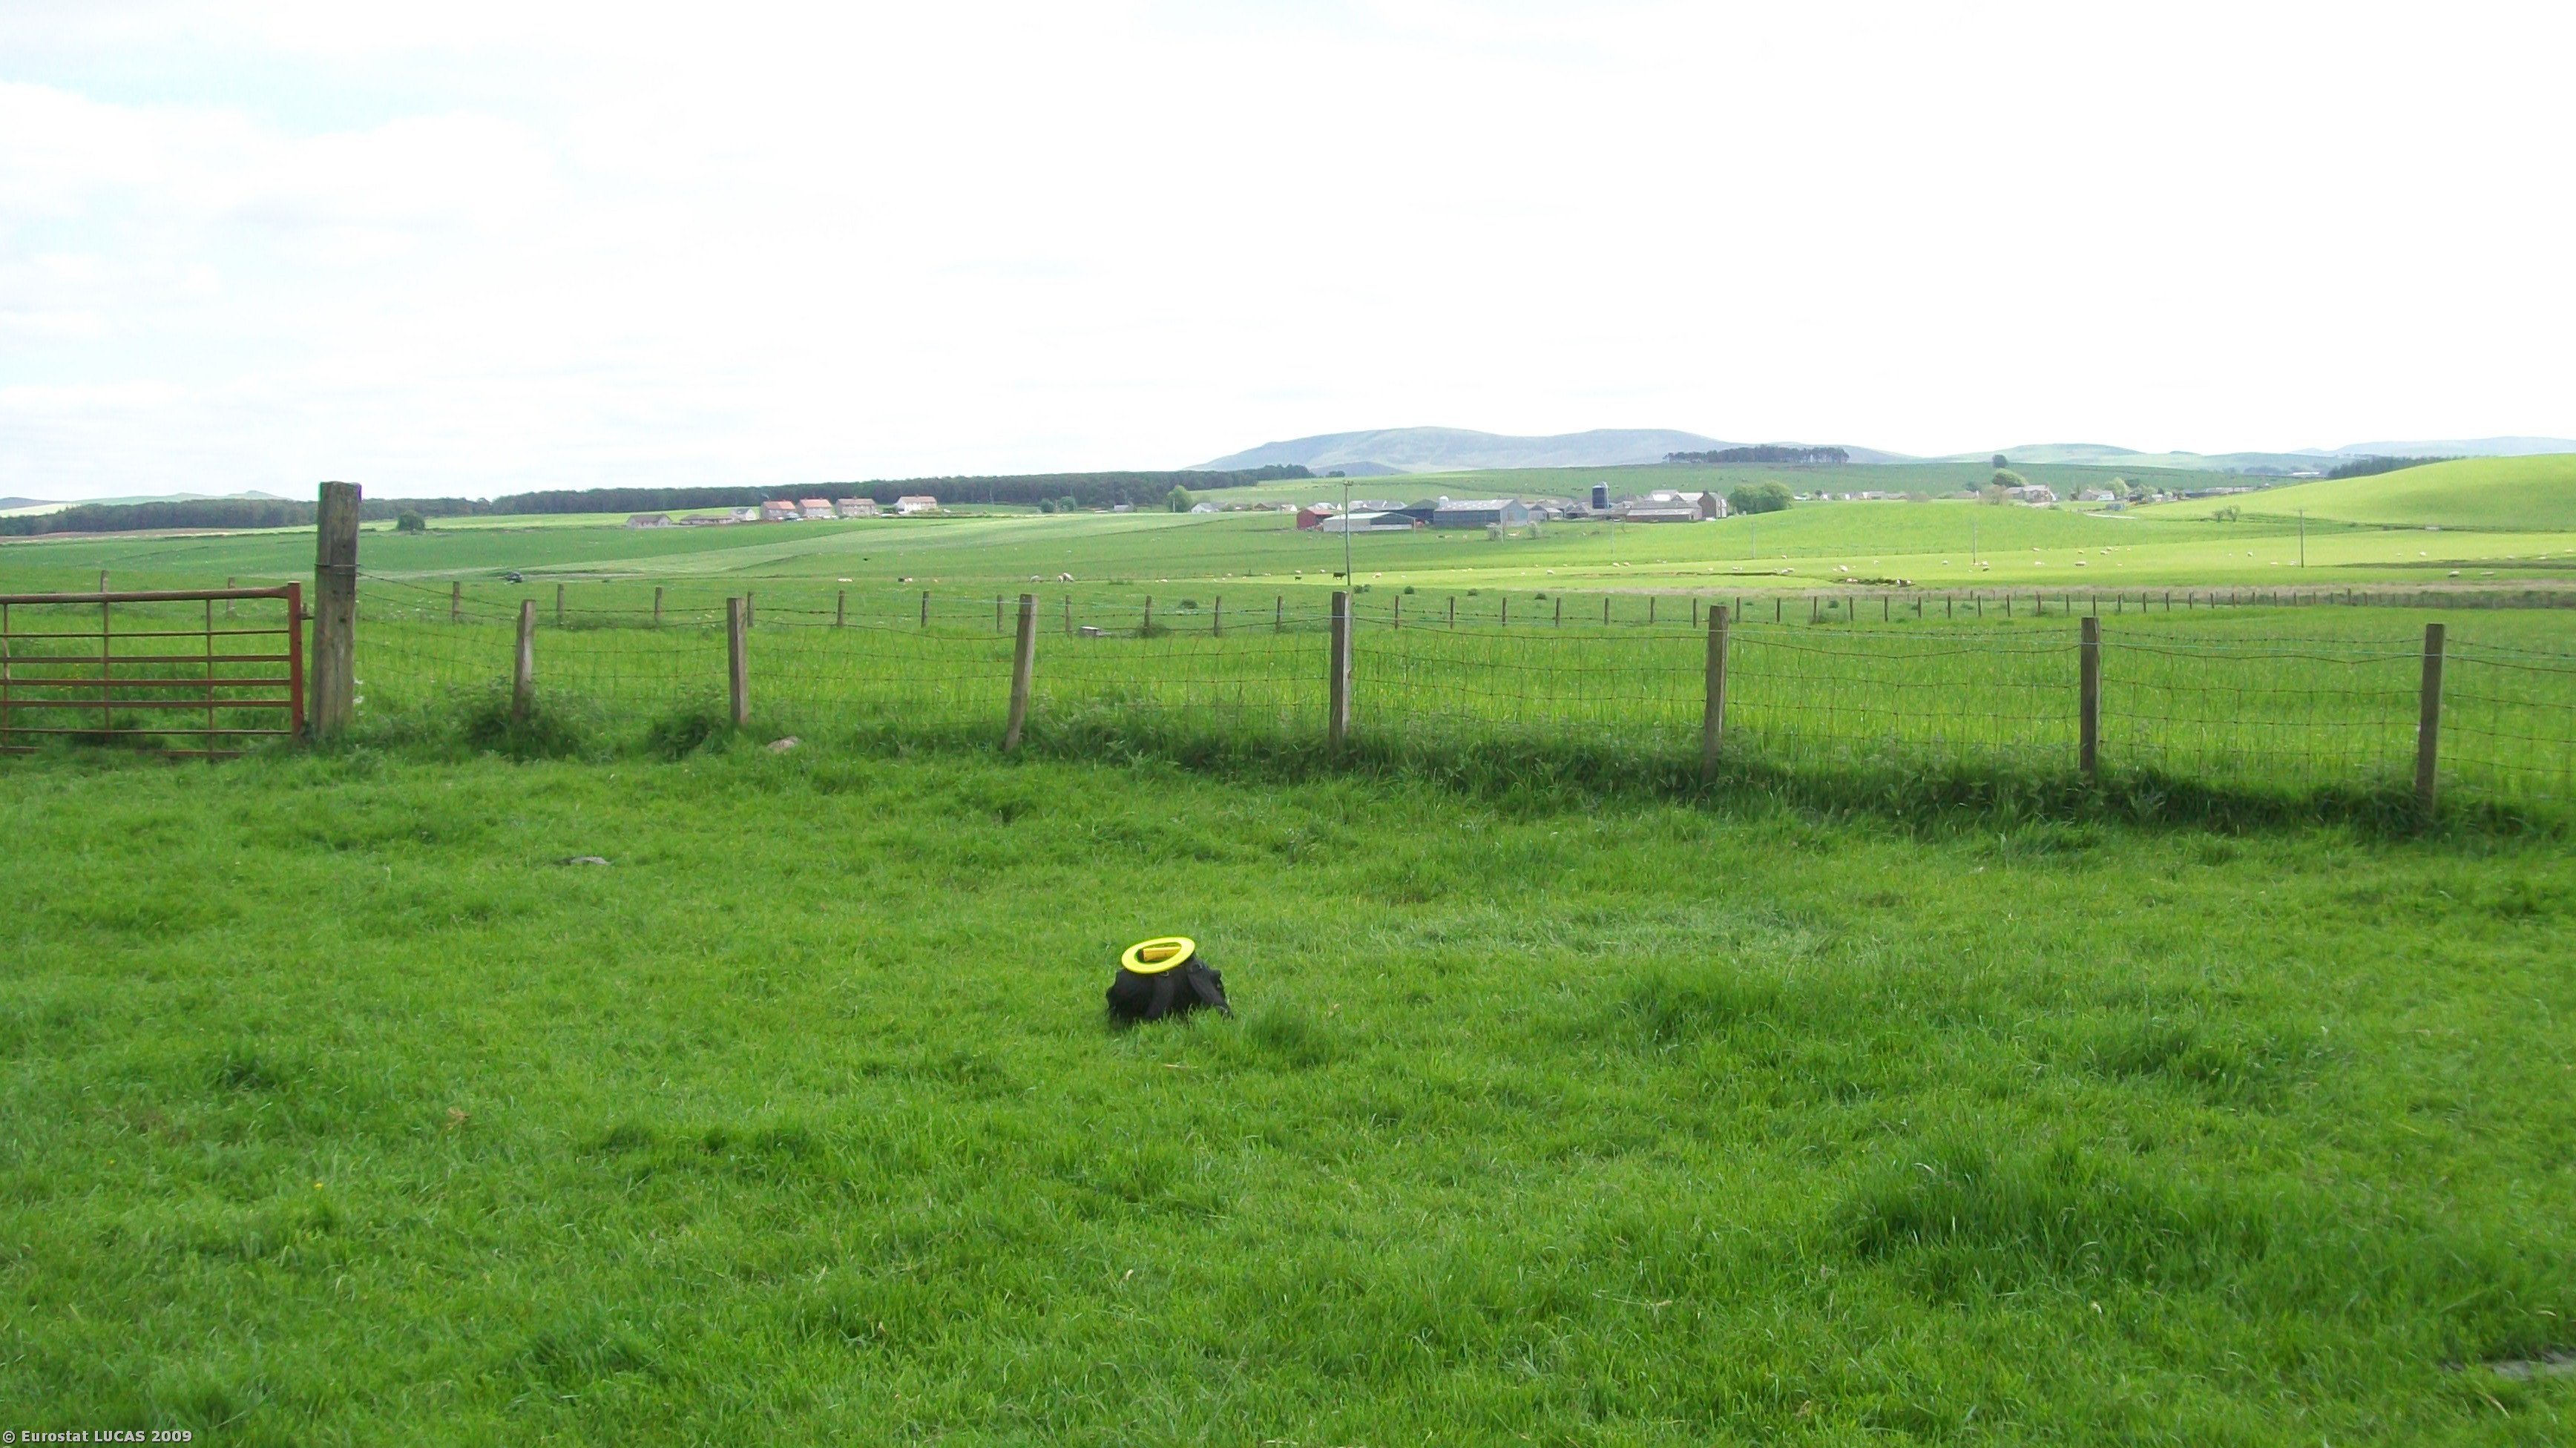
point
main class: Grassland
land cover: Grassland without tree/shrub cover
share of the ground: > 75 %
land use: Agriculture (excluding fallow land and kitchen gardens)
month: June
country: GB
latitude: 55.6978
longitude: -3.5882
